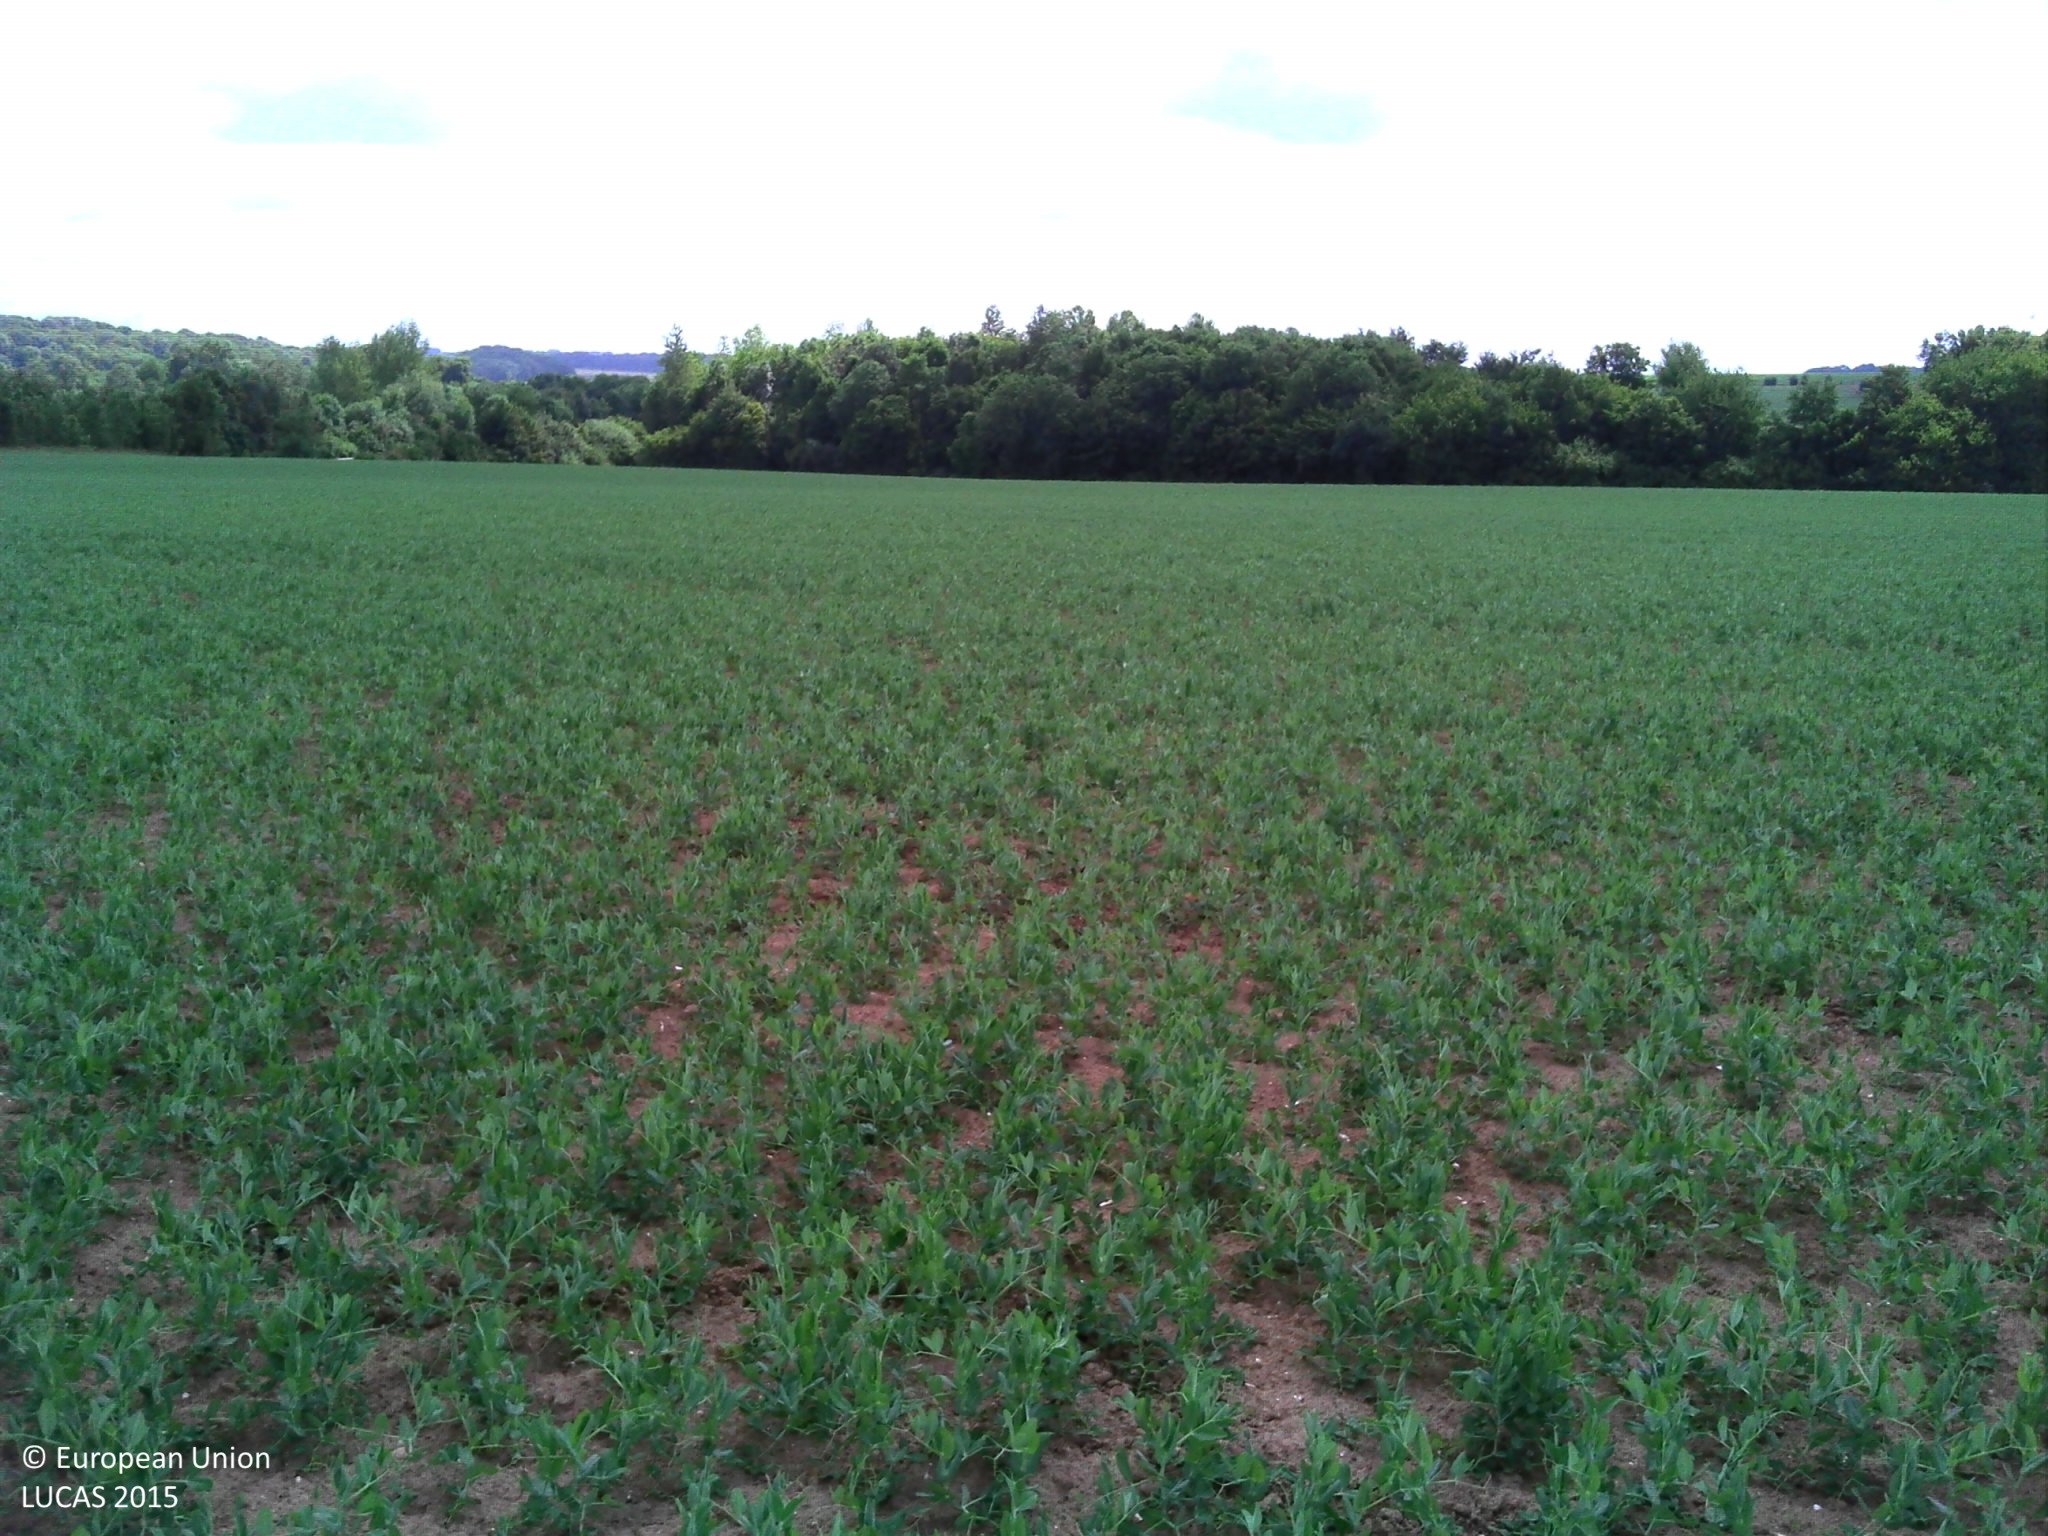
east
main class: Cropland
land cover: Other fresh vegetables
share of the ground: 50 - 75 %
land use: Agriculture (excluding fallow land and kitchen gardens)
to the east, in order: Other fresh vegetables; Grass margins; Tracks; Grass margins; Broadleaved woodland
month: June
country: FR
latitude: 50.3627
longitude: 2.3816
